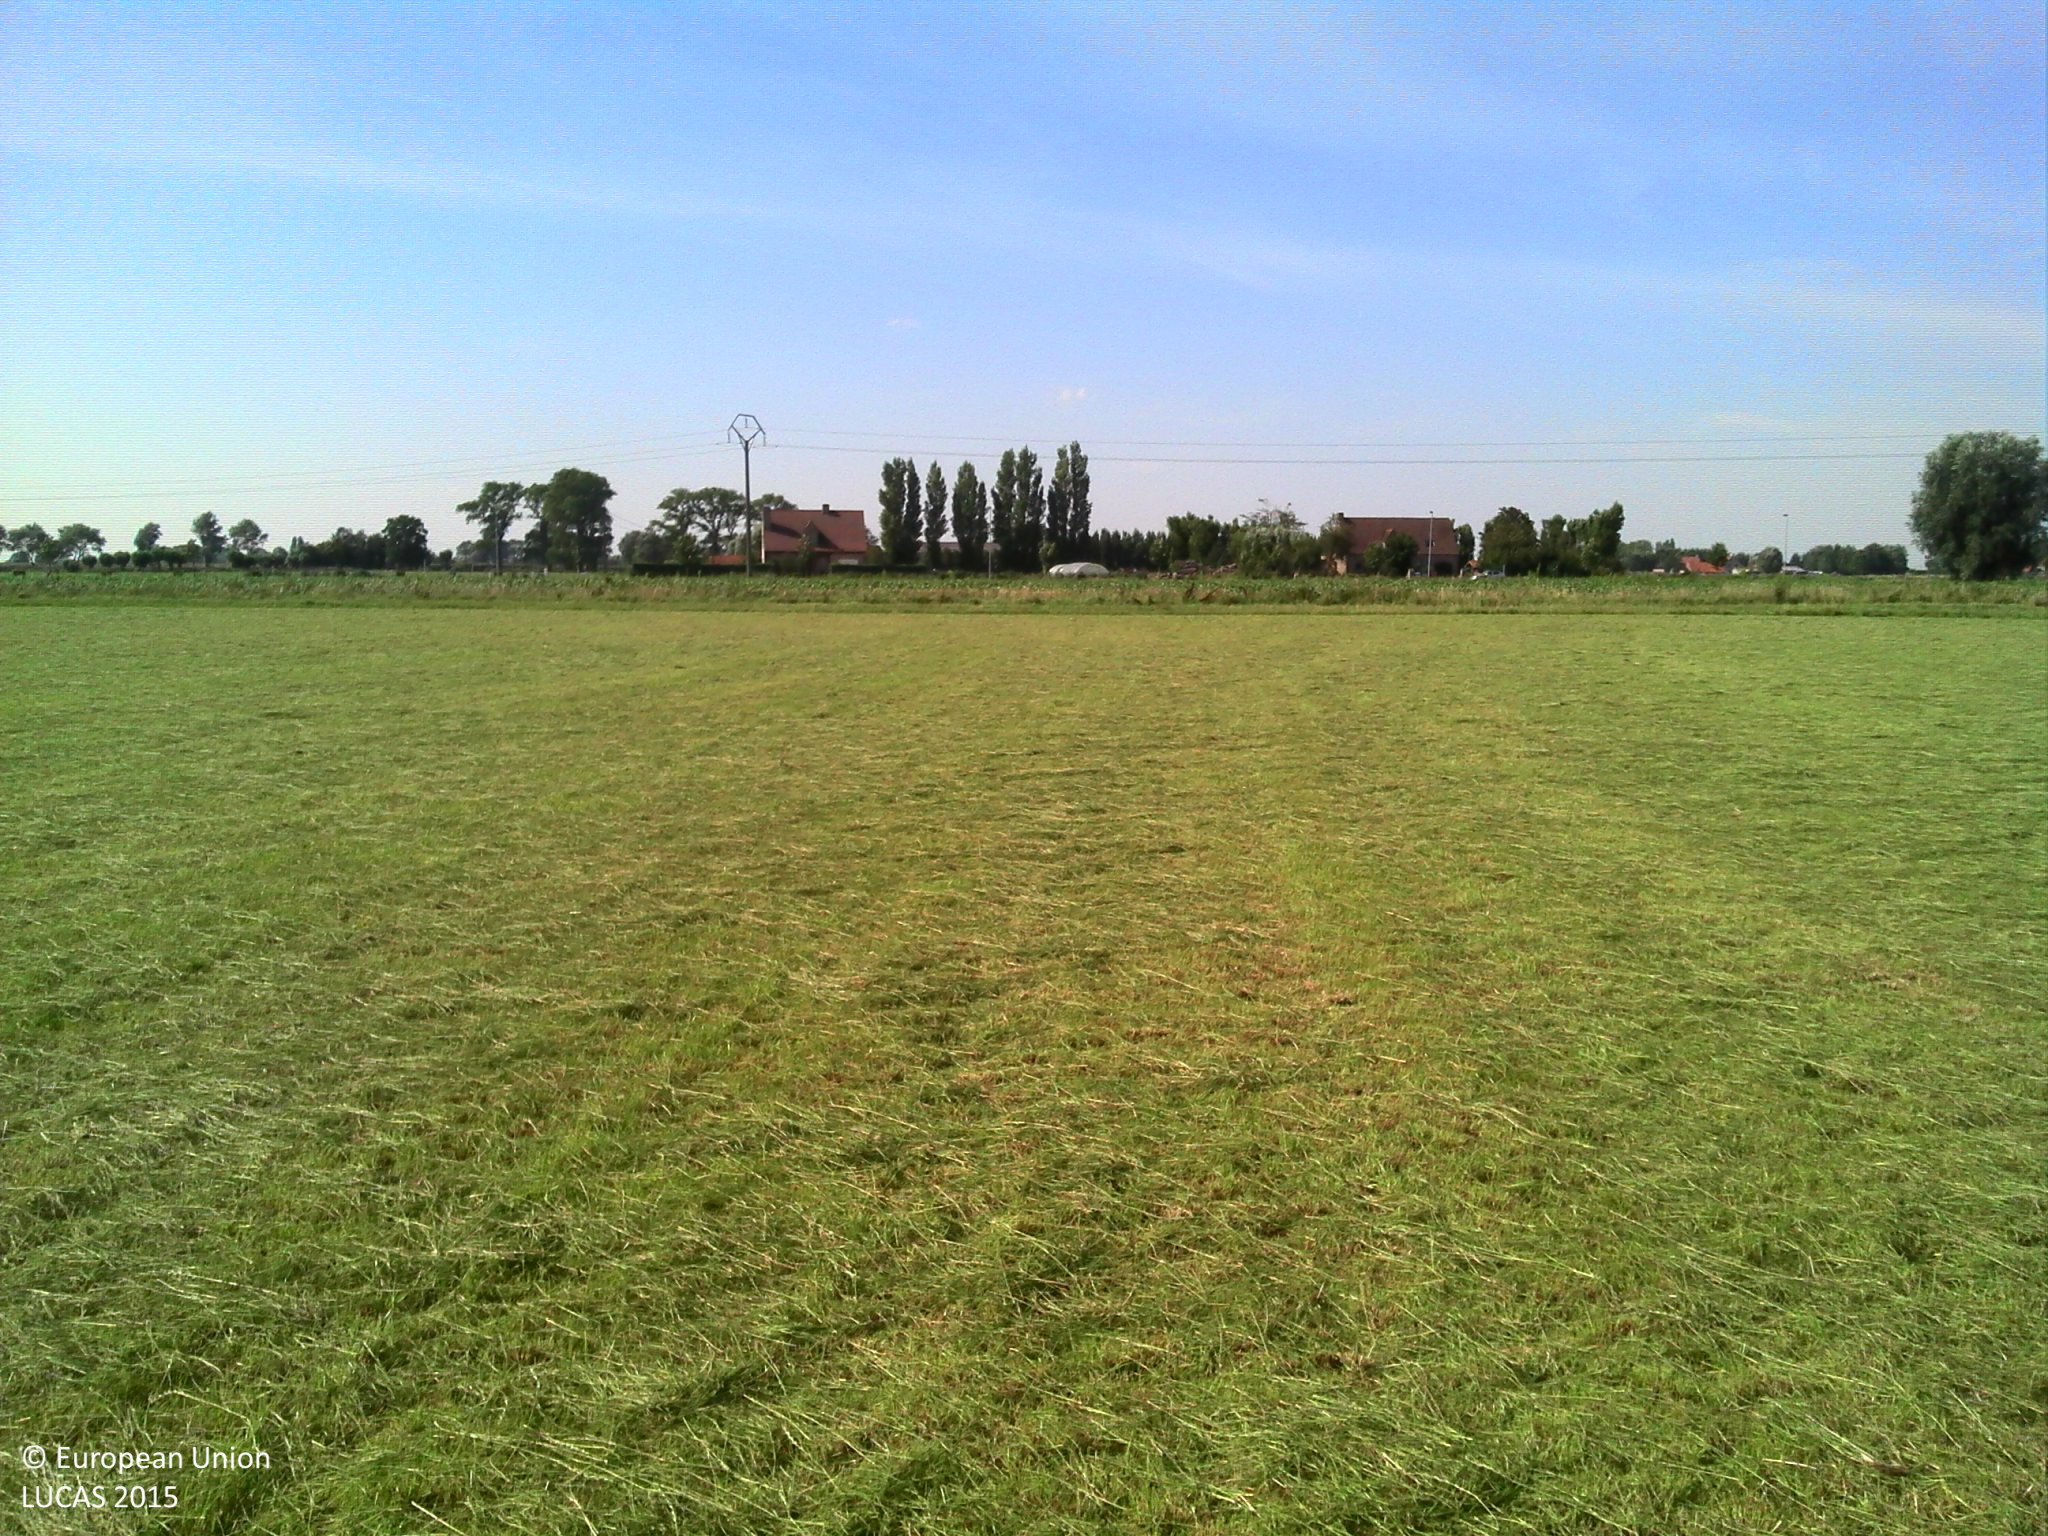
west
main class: Grassland
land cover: Grassland without tree/shrub cover
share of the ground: > 75 %
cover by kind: herbaceous plants 100 %
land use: Agriculture (excluding fallow land and kitchen gardens)
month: September
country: BE
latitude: 51.1762
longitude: 2.9664
